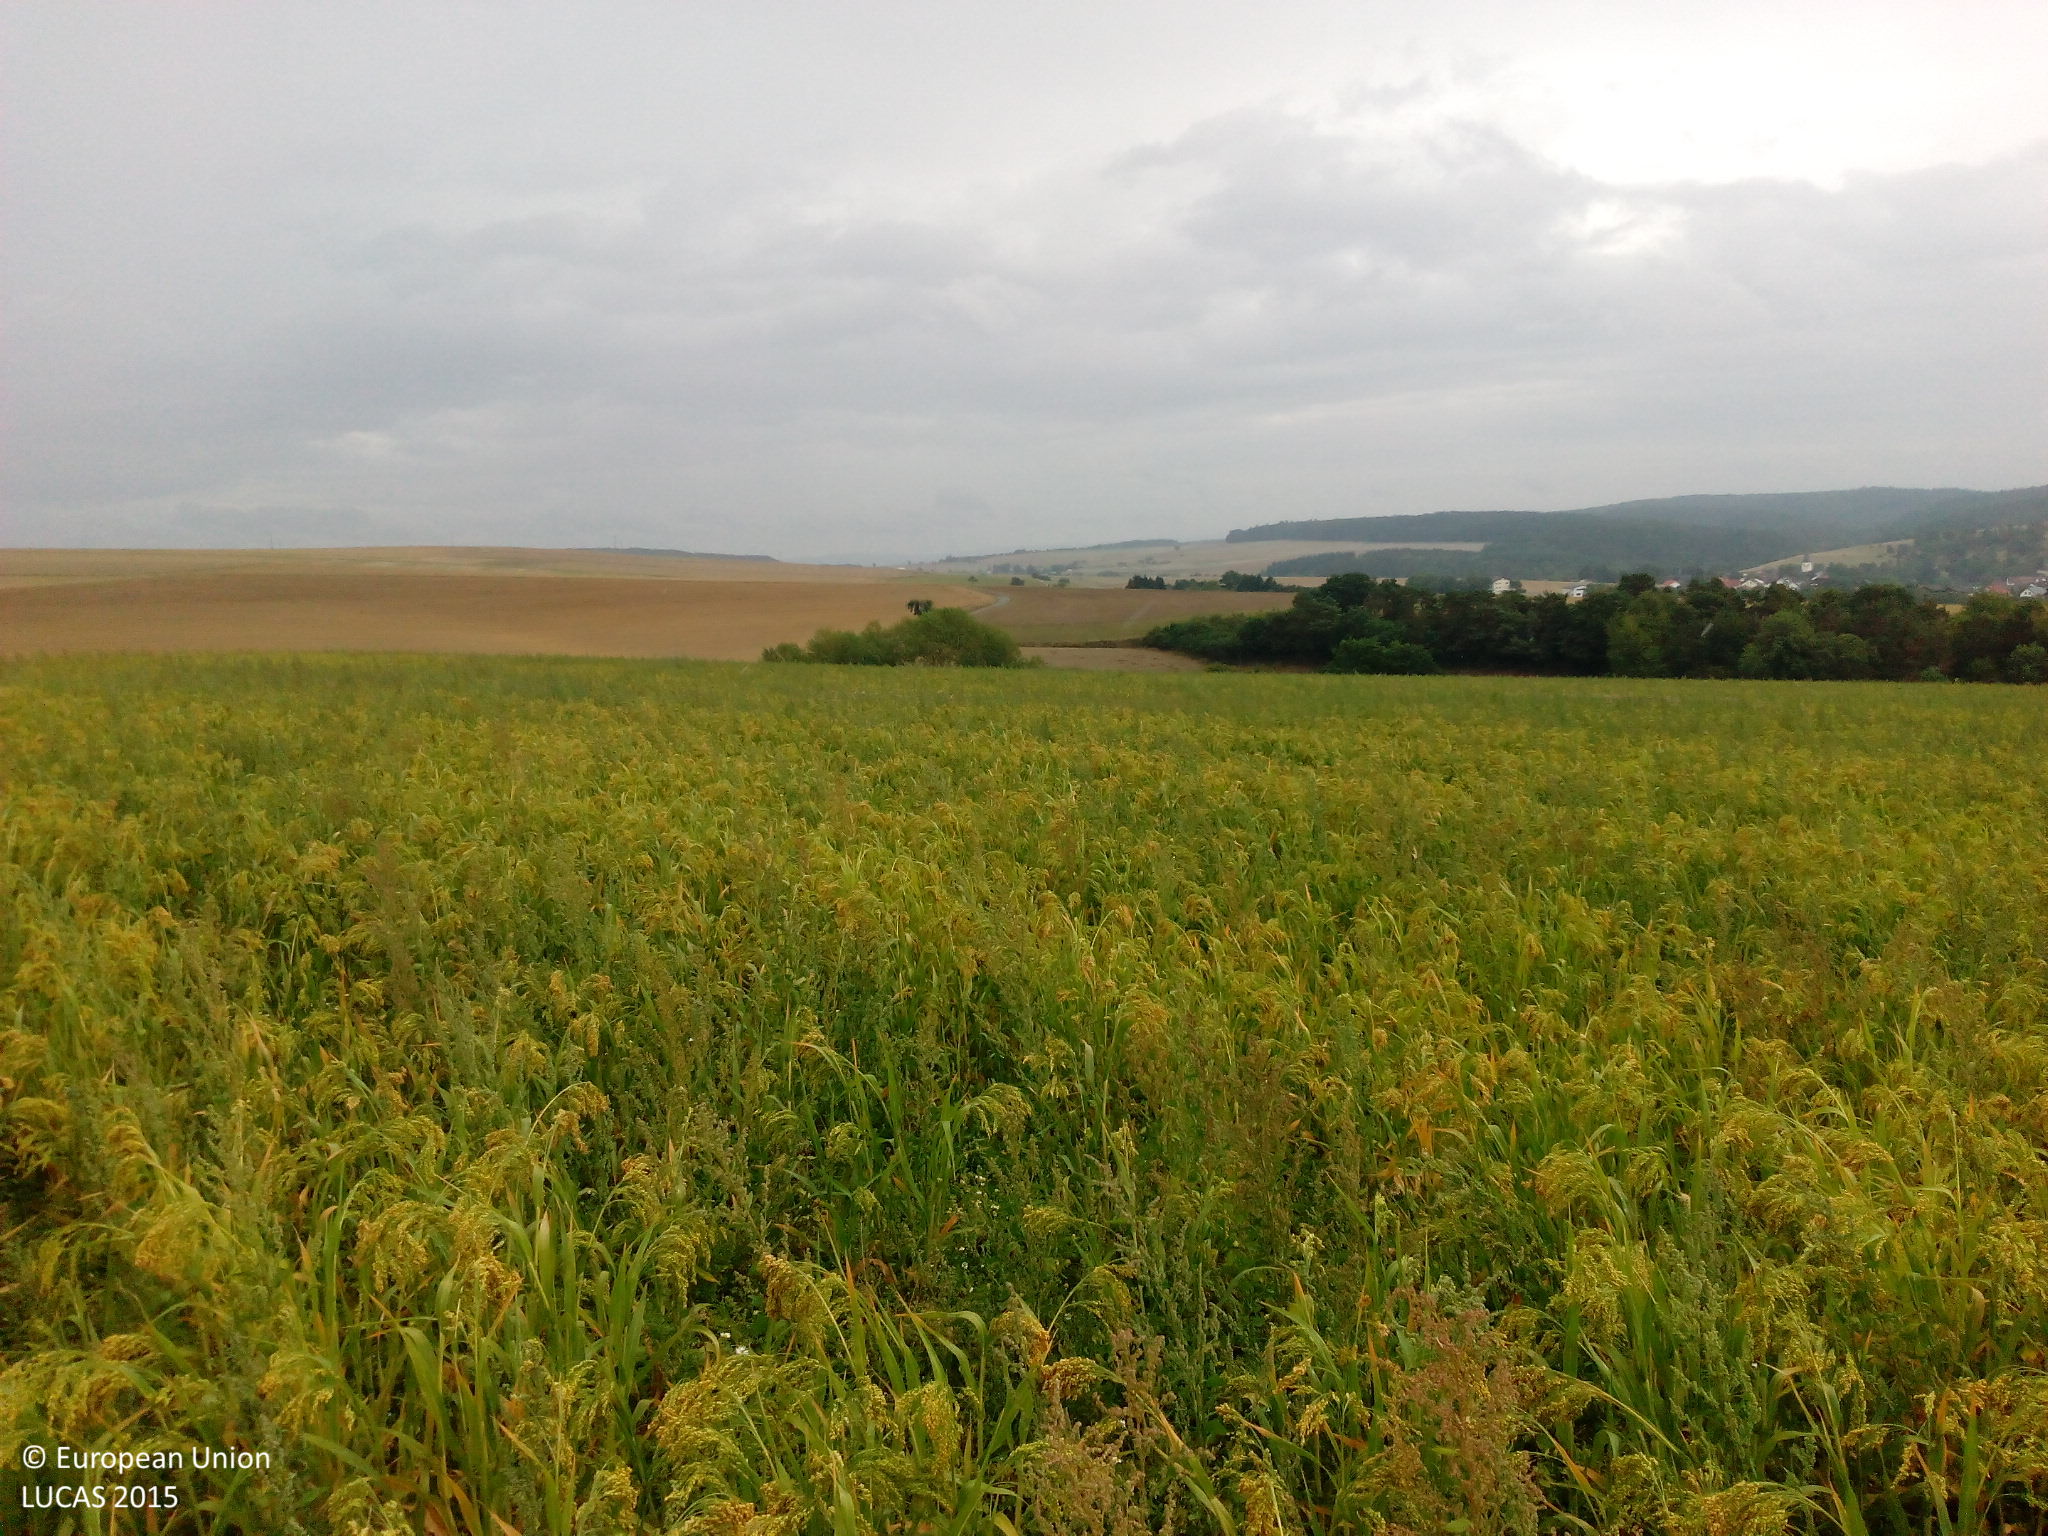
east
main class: Cropland
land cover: Other cereals
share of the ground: > 75 %
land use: Agriculture (excluding fallow land and kitchen gardens)
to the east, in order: Other cereals; Tracks; Oats
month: August
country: DE
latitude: 50.2409
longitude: 8.1355
